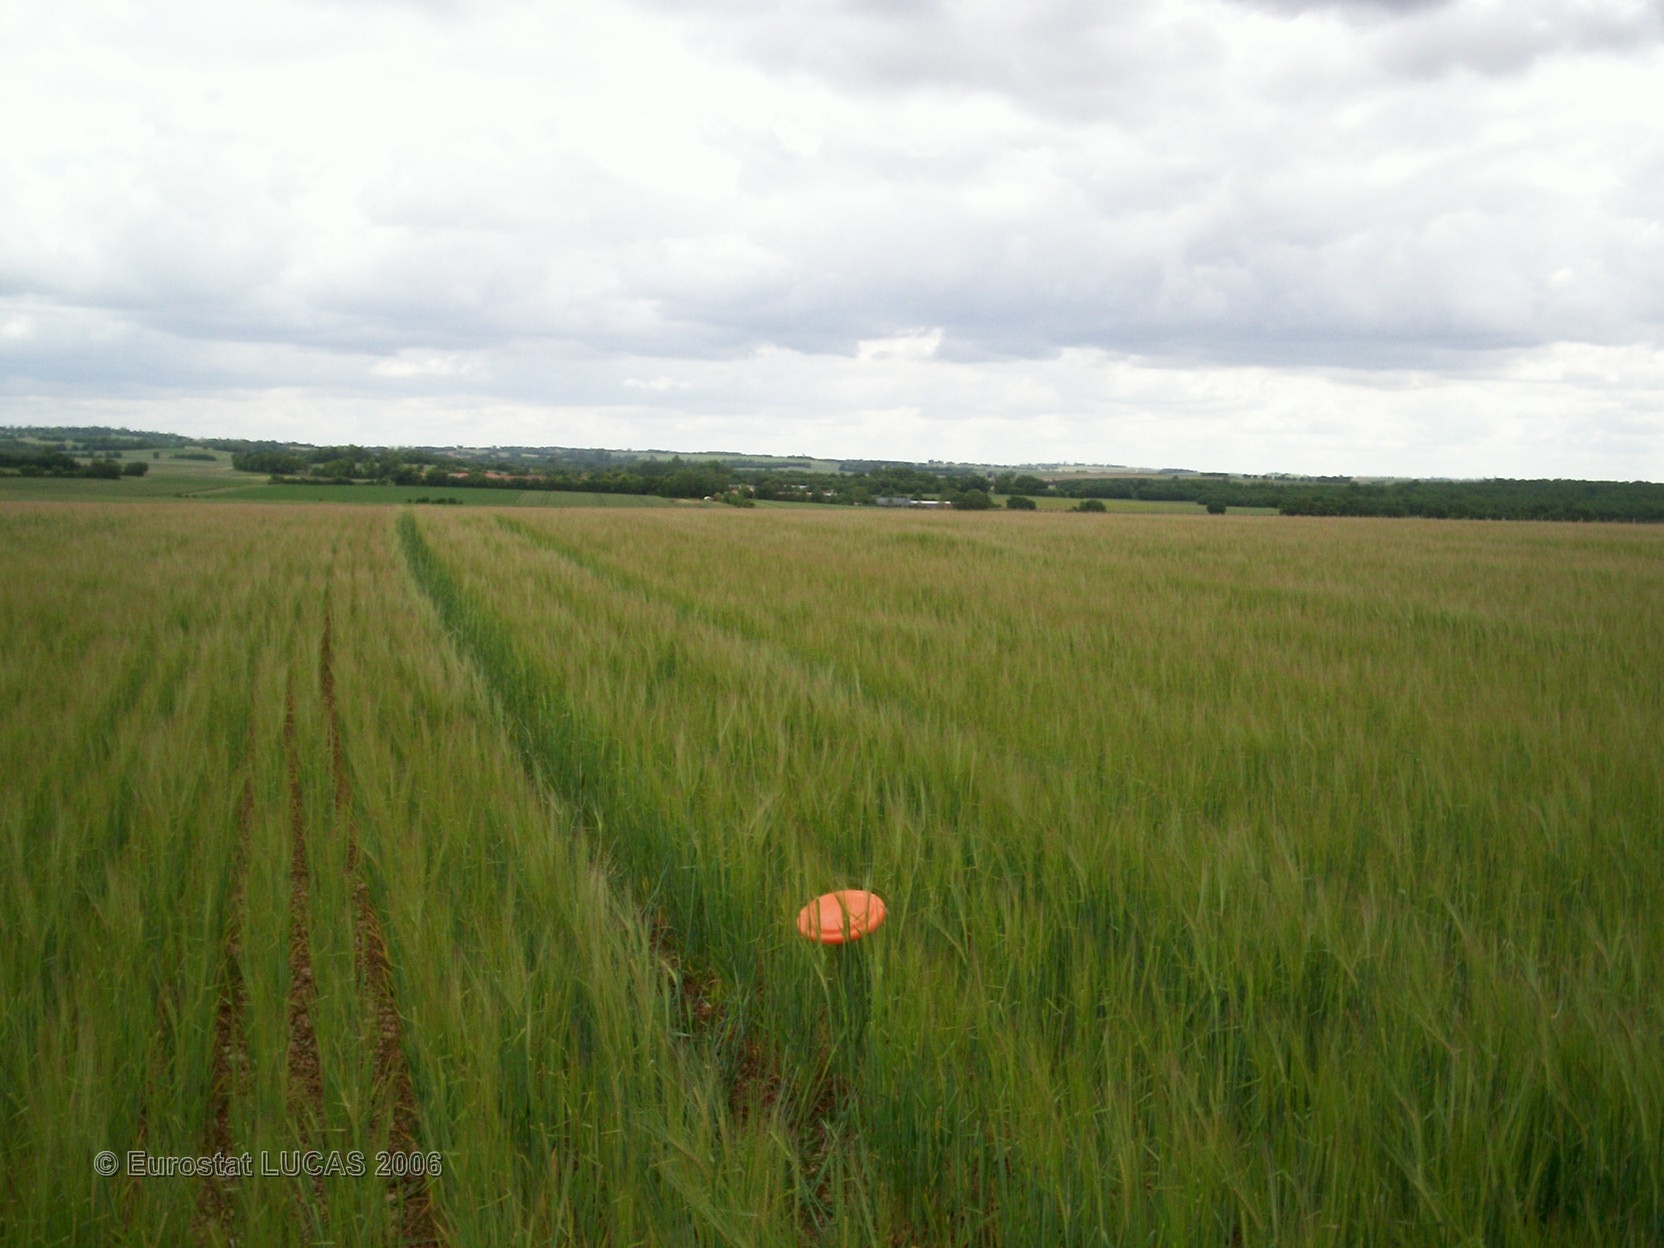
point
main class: Cropland
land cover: Barley
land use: Agriculture (excluding fallow land and kitchen gardens)
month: May
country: FR
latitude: 45.9328
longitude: -0.2225
